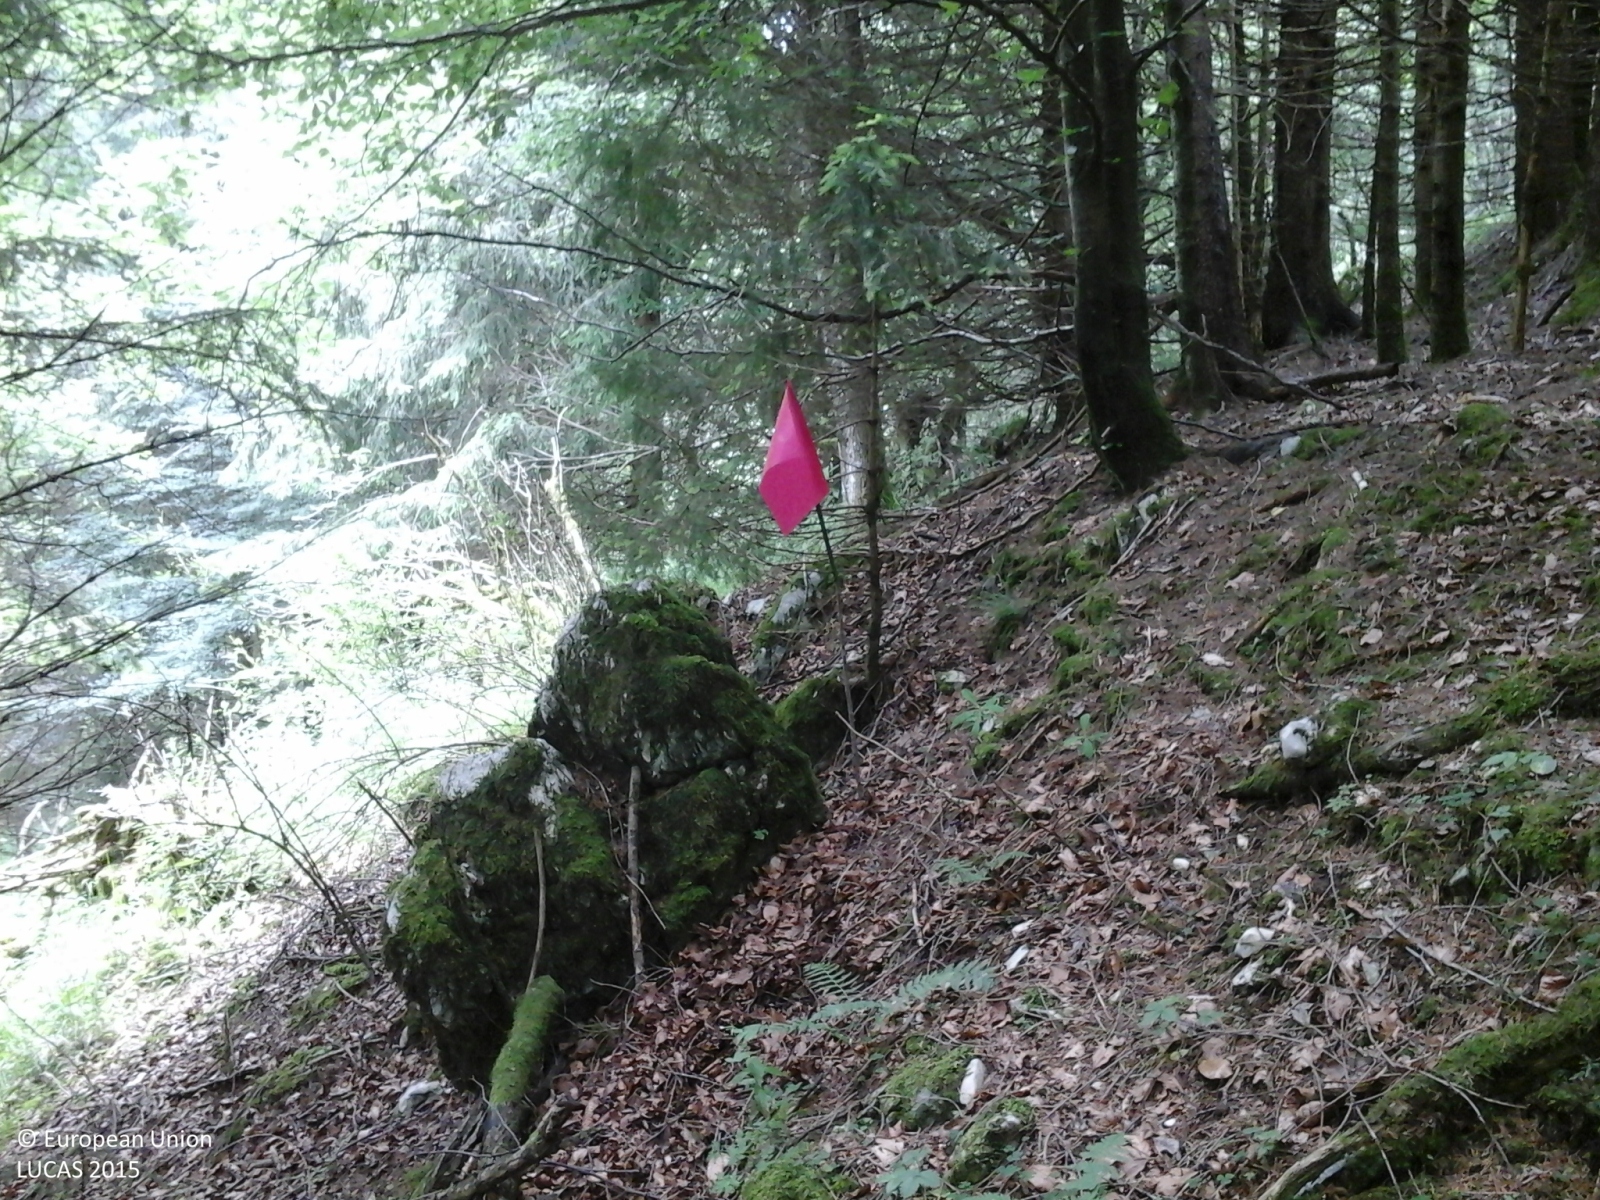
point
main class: Woodland
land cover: Spruce dominated mixed woodland
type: alpine coniferous forest
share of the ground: > 75 %
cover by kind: coniferous forest trees 75 %, broadleaved forest trees 25 %
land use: Semi-natural and natural areas not in use
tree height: > 5 m
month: June
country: IT
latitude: 46.0897
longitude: 12.4155
